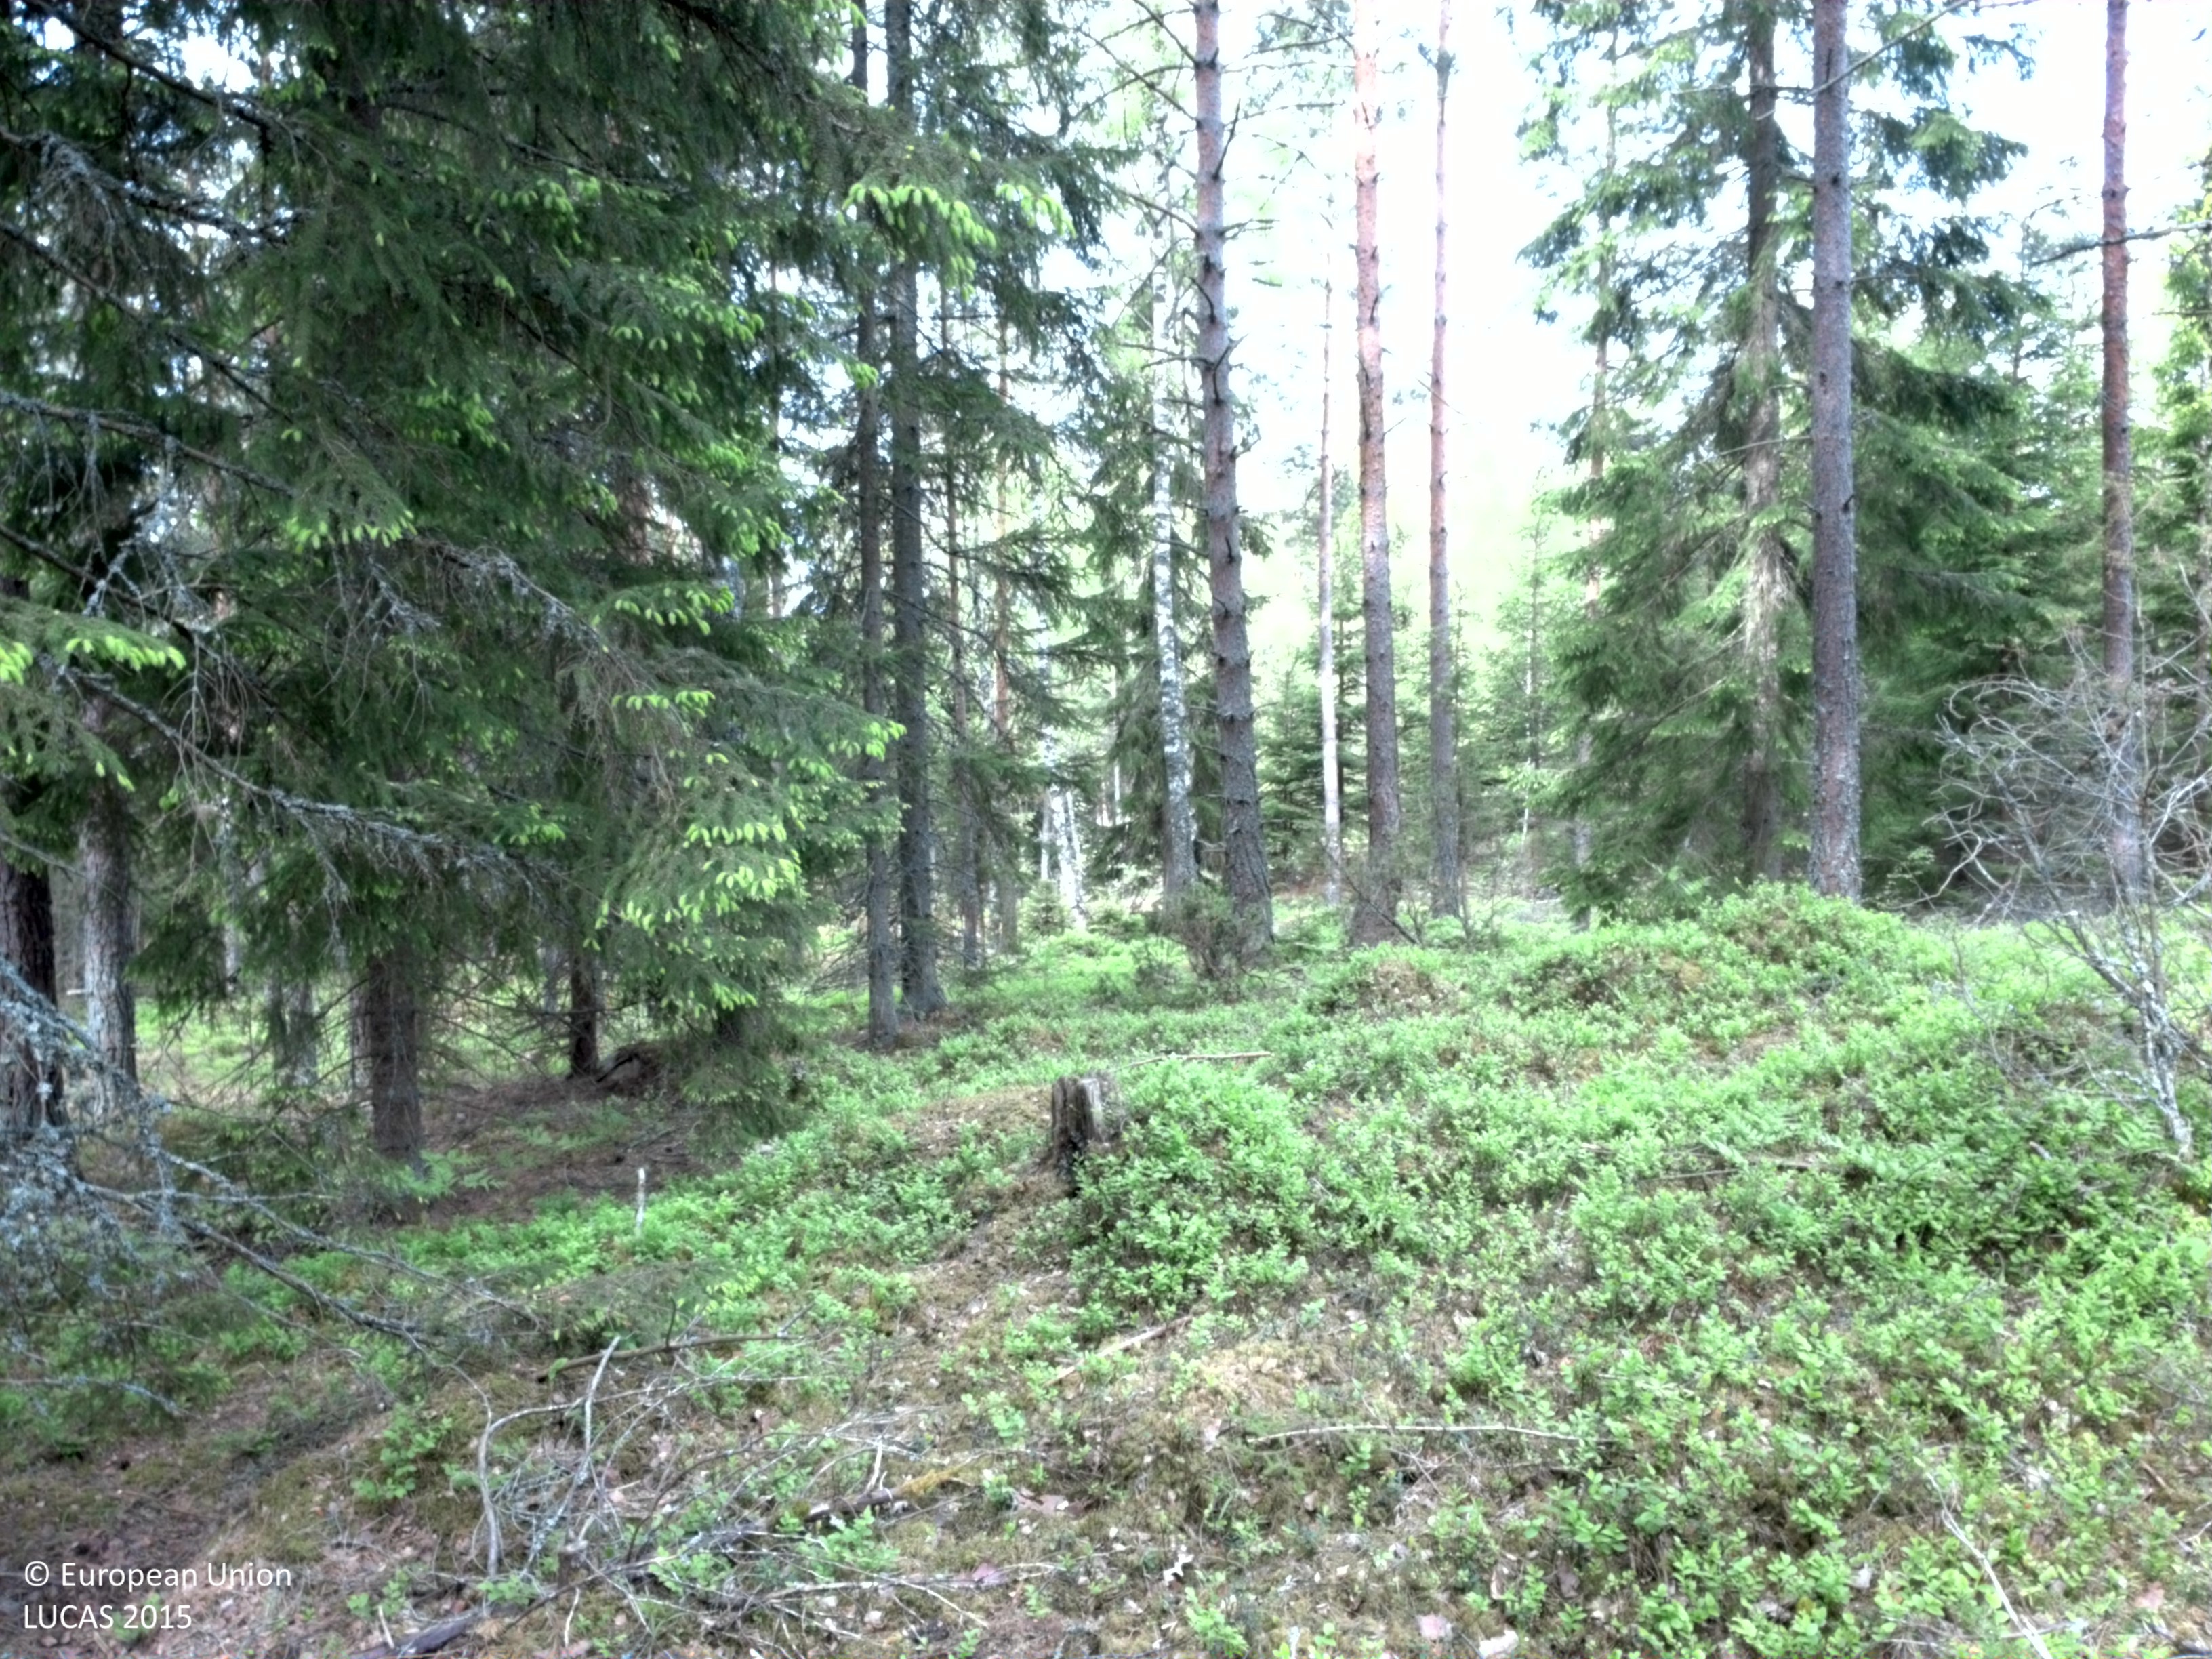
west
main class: Woodland
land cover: Pine dominated mixed woodland
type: boreal forest
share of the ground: 25 - 50 %
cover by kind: coniferous forest trees 25 %, broadleaved forest trees 25 %, shrubs 25 %, lichens and mosses 20 %, herbaceous plants 5 %
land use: Forestry
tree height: > 5 m
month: May
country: SE
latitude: 57.3456
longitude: 15.5973
